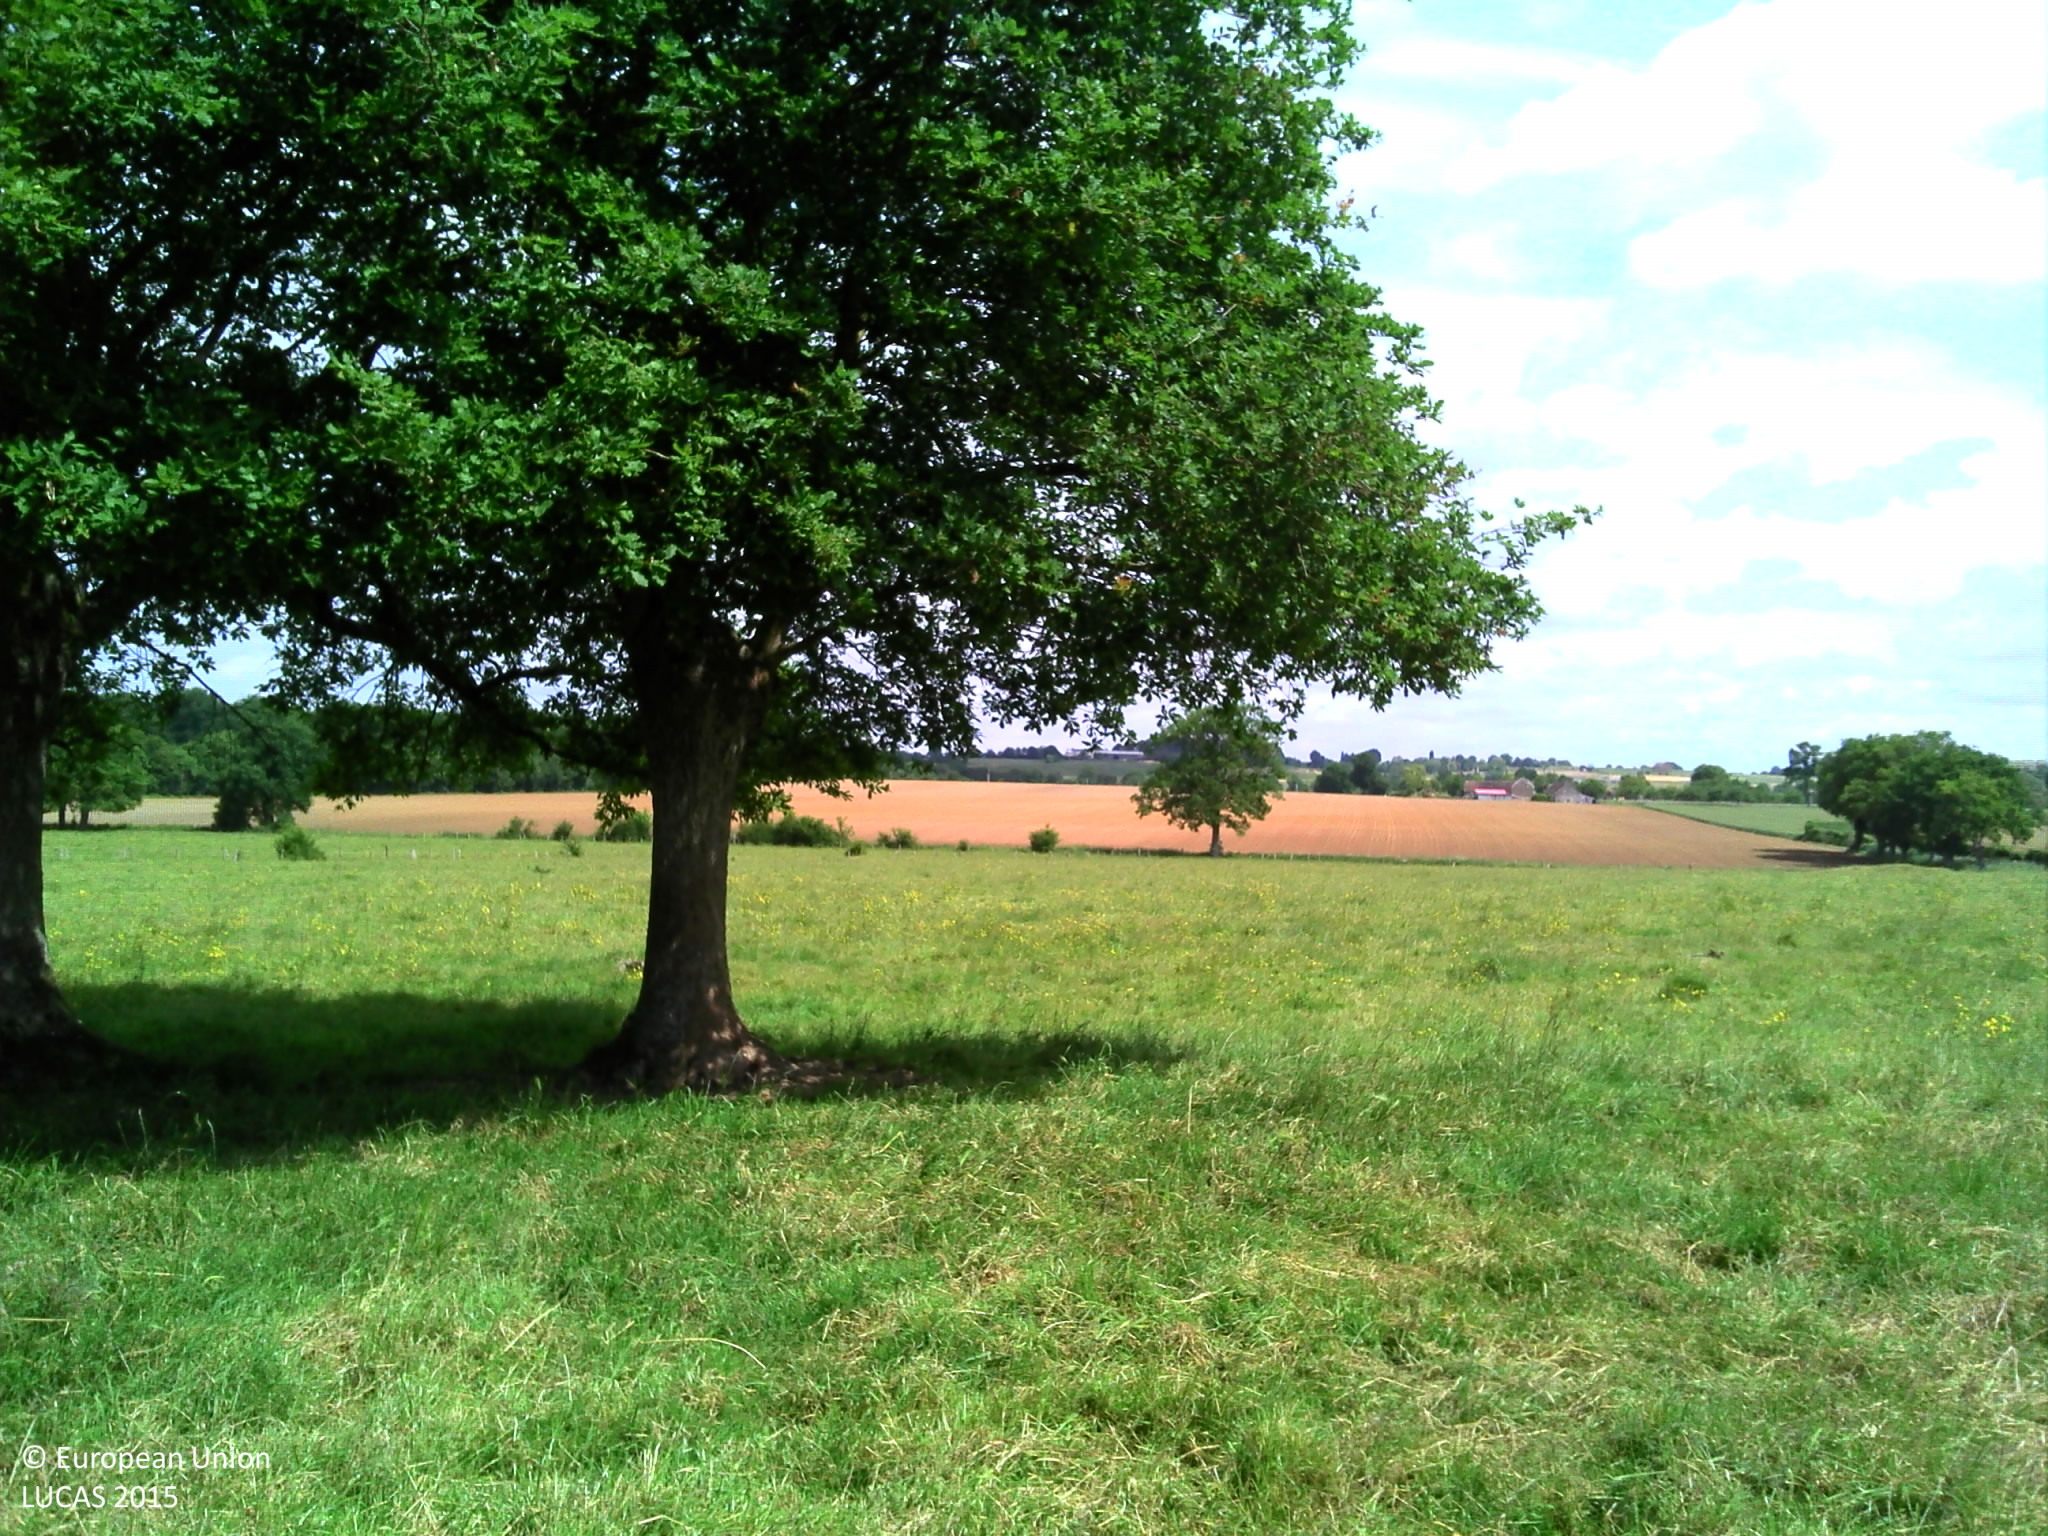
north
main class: Grassland
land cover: Grassland with sparse tree/shrub cover
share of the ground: > 75 %
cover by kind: herbaceous plants 95 %, broadleaved forest trees 5 %
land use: Agriculture (excluding fallow land and kitchen gardens)
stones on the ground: < 10 %
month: May
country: FR
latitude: 47.9666
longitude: -0.0064
